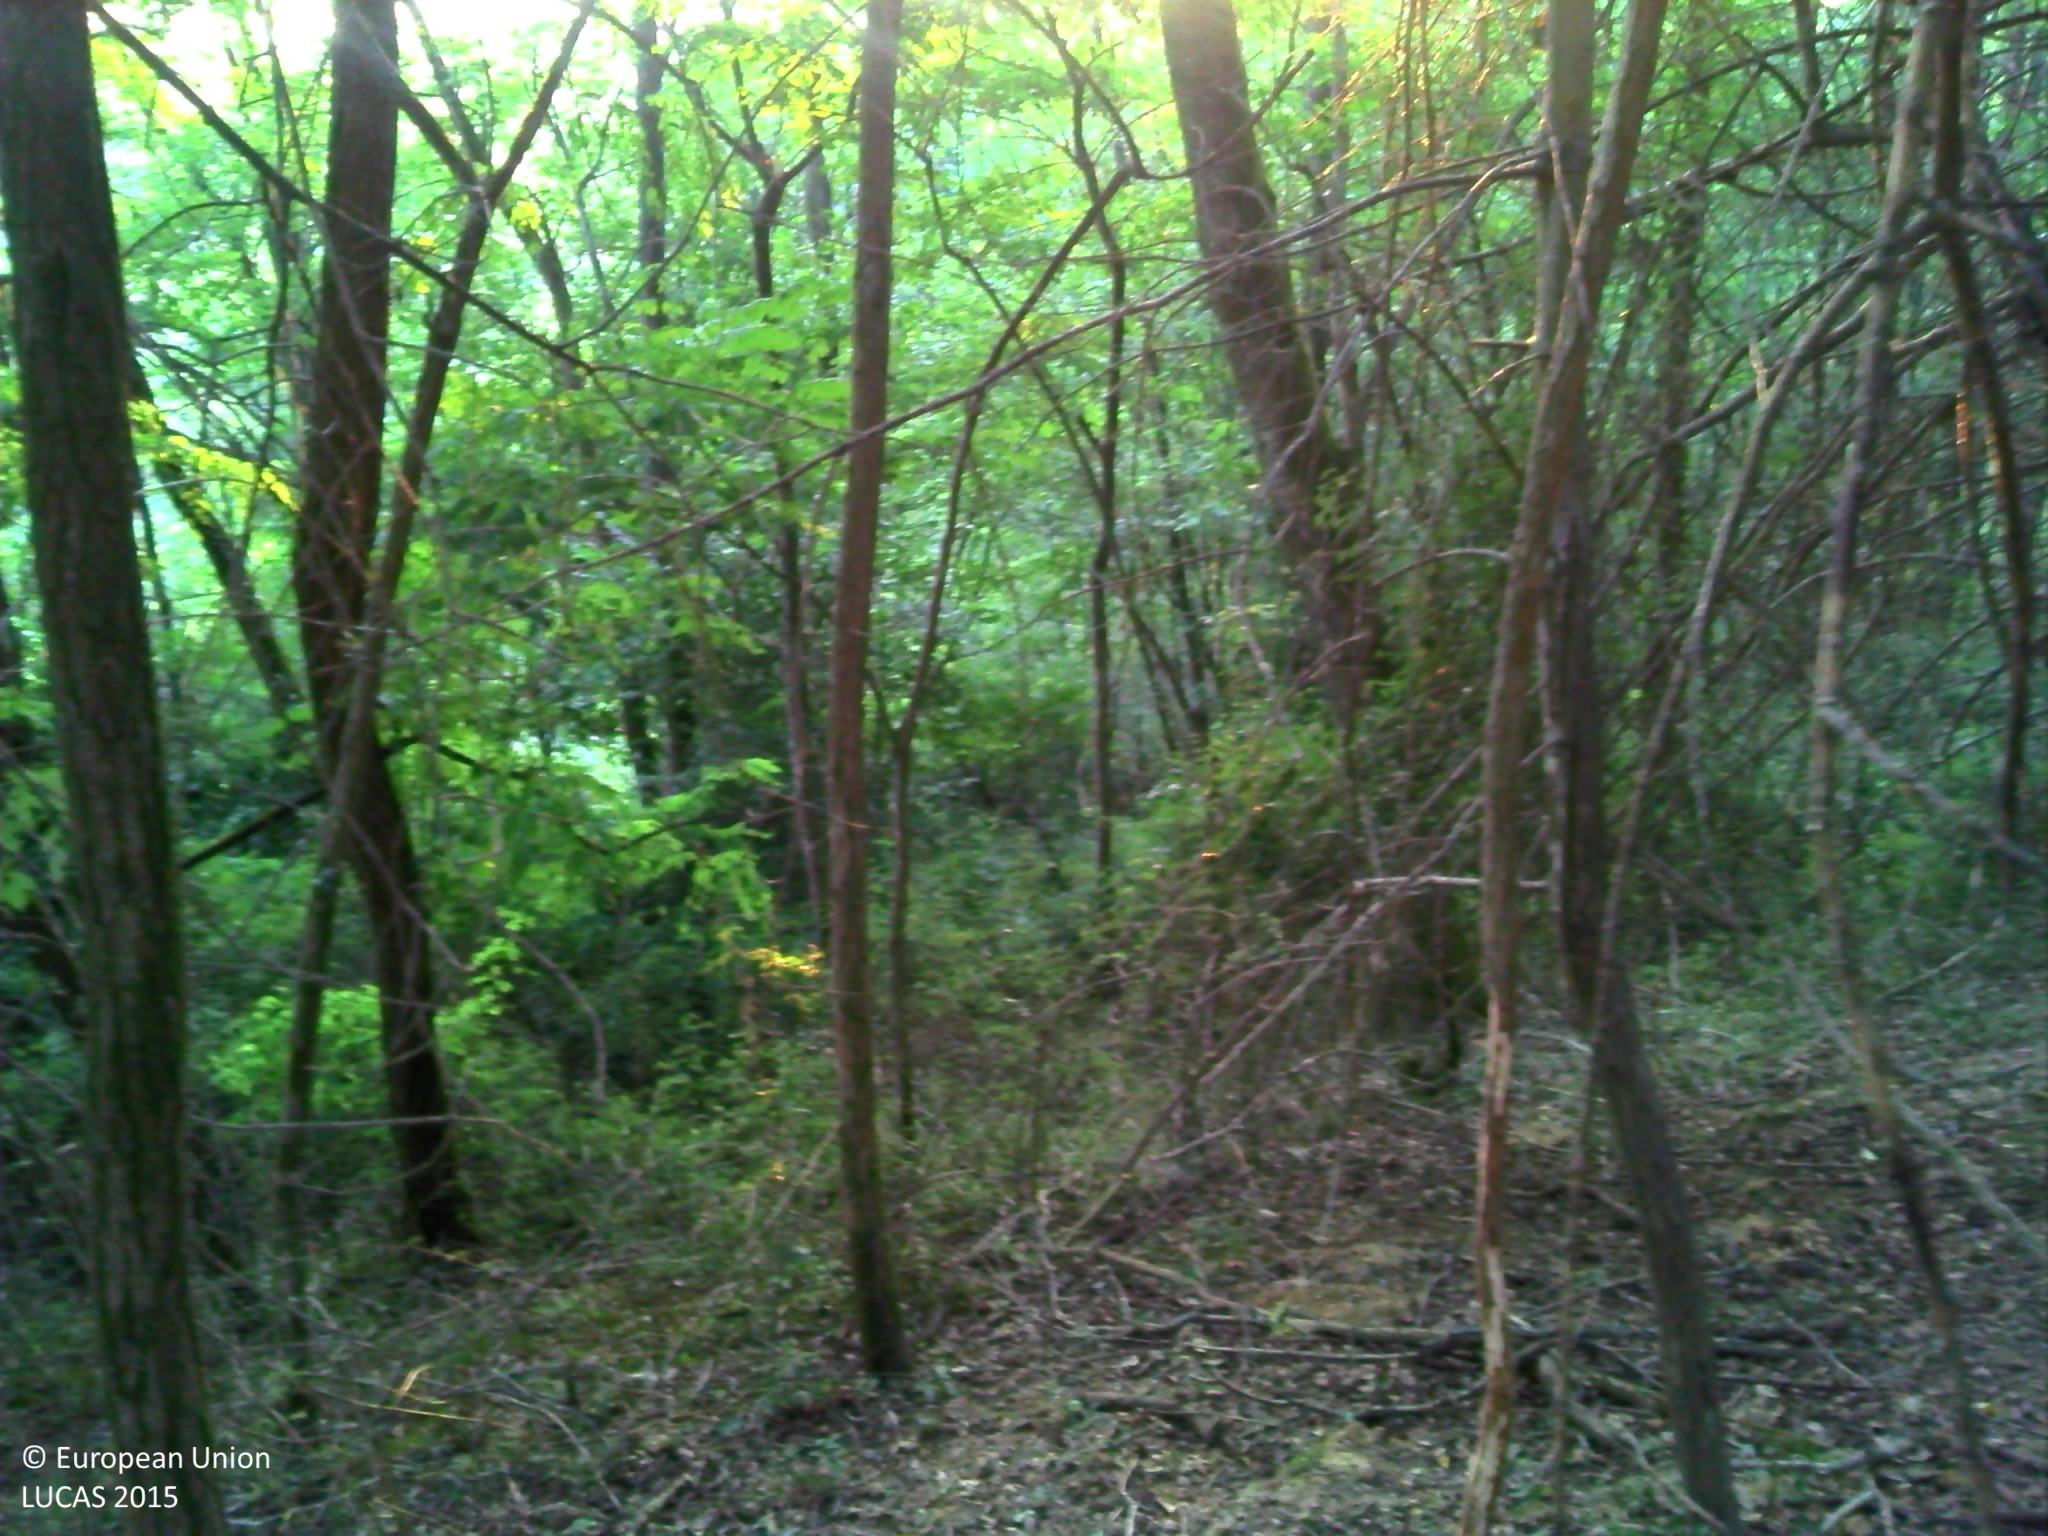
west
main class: Woodland
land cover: Broadleaved woodland
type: thermophilous deciduous forest
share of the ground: > 75 %
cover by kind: broadleaved forest trees 90 %, unconsolidated bare surface 10 %
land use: Forestry
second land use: Agriculture (excluding fallow land and kitchen gardens)
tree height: > 5 m
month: August
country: FR
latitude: 43.4289
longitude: -1.0697
